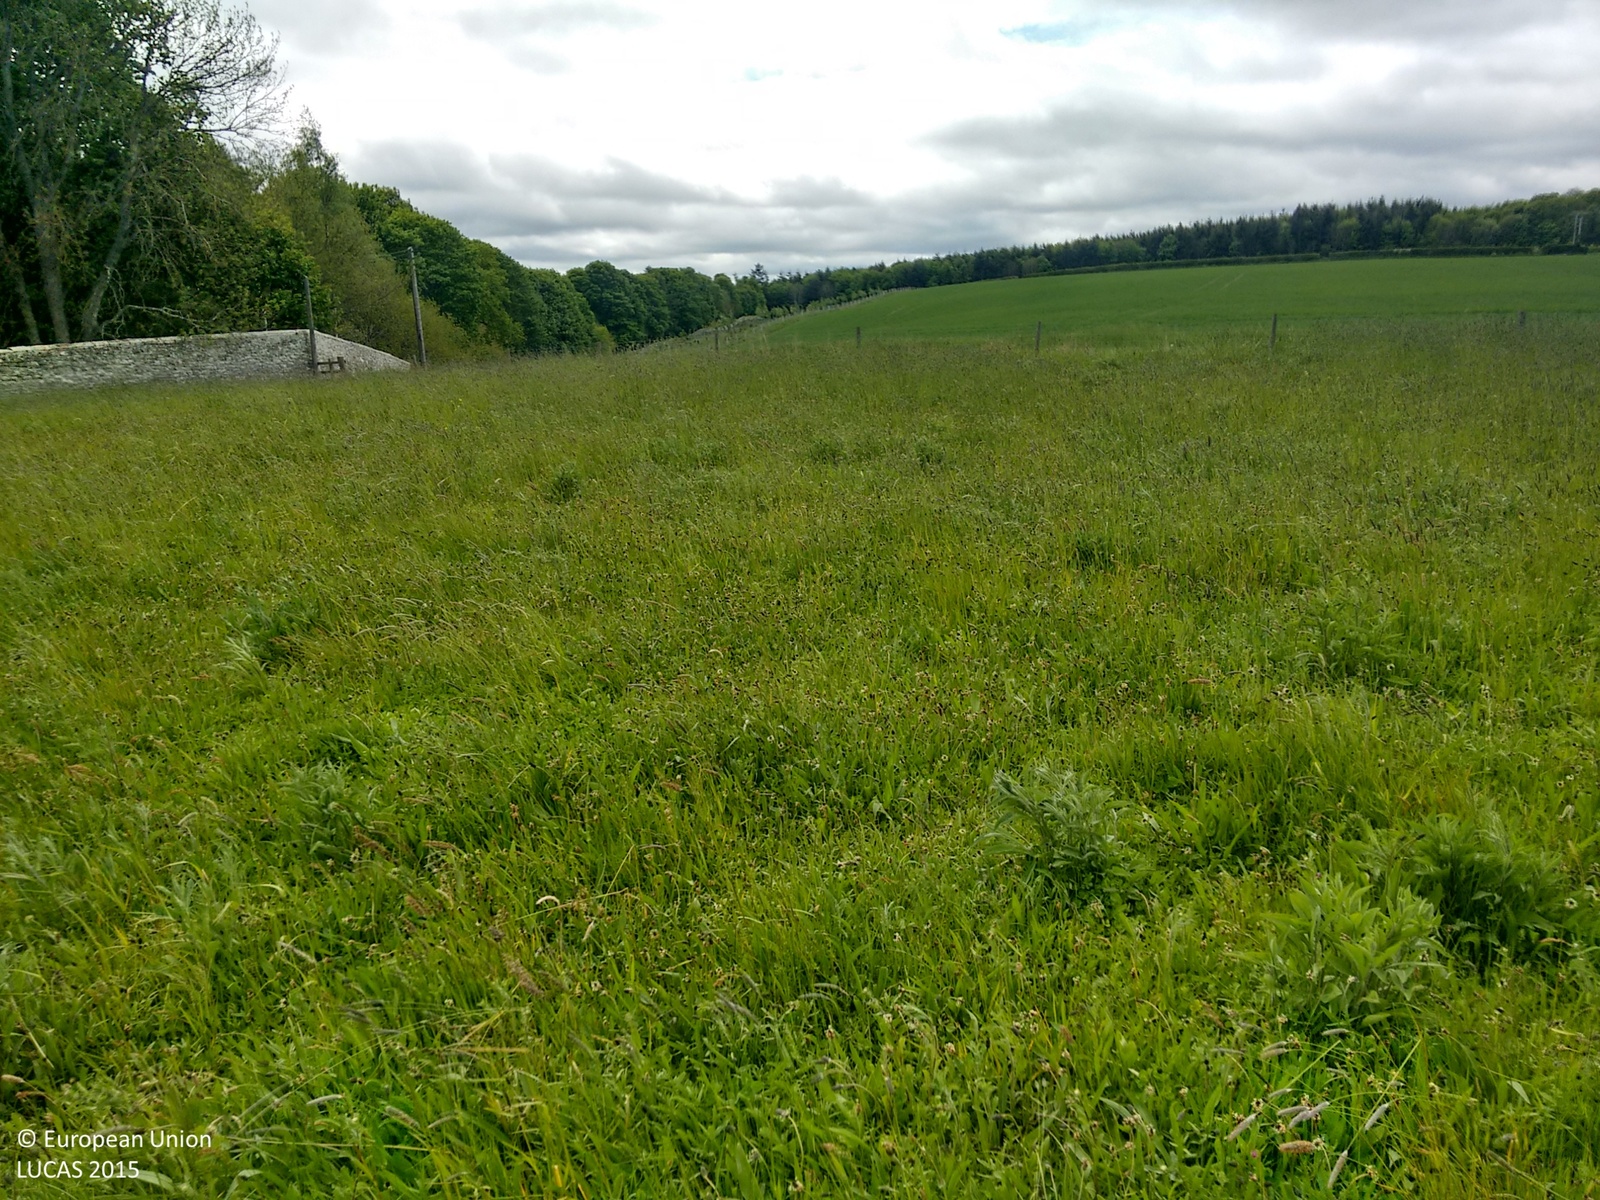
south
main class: Grassland
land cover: Grassland without tree/shrub cover
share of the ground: > 75 %
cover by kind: herbaceous plants 100 %
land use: Agriculture (excluding fallow land and kitchen gardens)
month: May
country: GB
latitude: 55.6201
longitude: -2.3970
